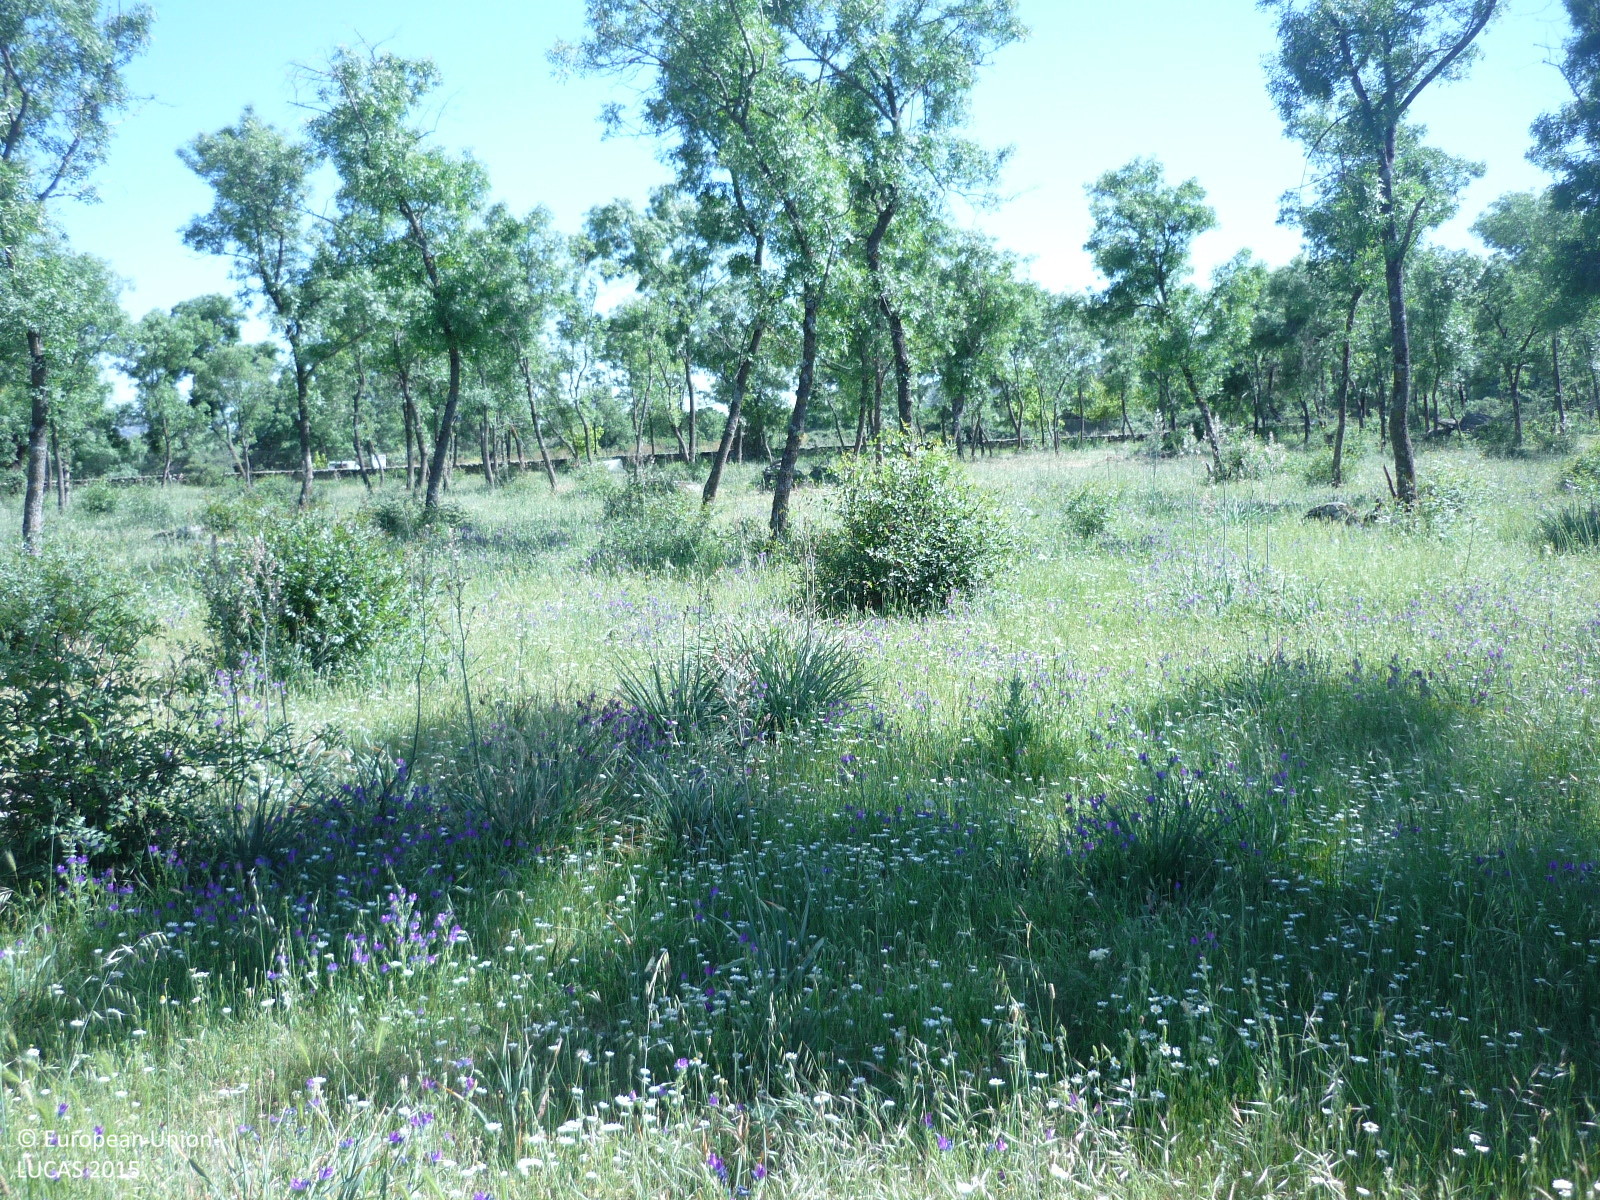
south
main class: Woodland
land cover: Broadleaved woodland
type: thermophilous deciduous forest
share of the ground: 50 - 75 %
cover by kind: broadleaved forest trees 70 %, herbaceous plants 20 %, shrubs 10 %
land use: Forestry
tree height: < 5 m
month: May
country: ES
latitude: 40.7091
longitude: -3.9768
